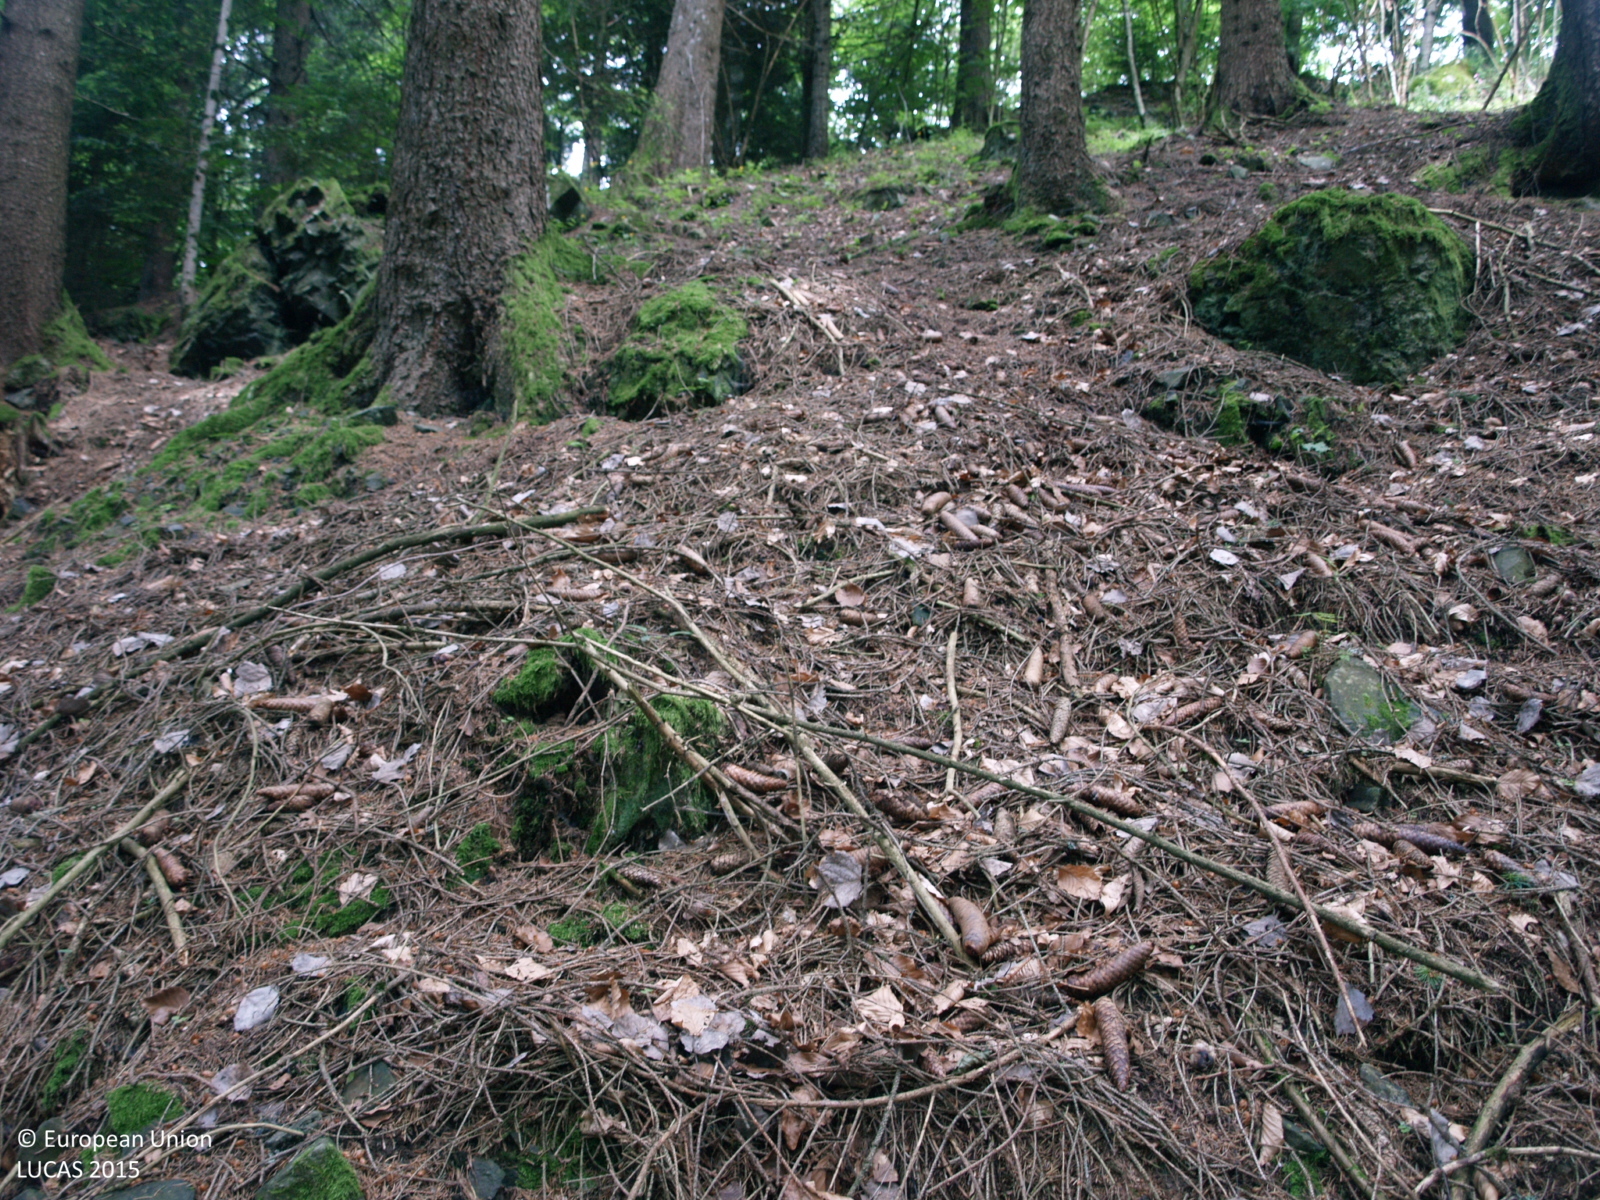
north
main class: Woodland
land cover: Spruce dominated coniferous woodland
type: alpine coniferous forest
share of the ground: > 75 %
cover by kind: coniferous forest trees 80 %, shrubs 10 %, herbaceous plants 10 %
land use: Forestry
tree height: > 5 m
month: May
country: IT
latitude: 46.0876
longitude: 11.5627
